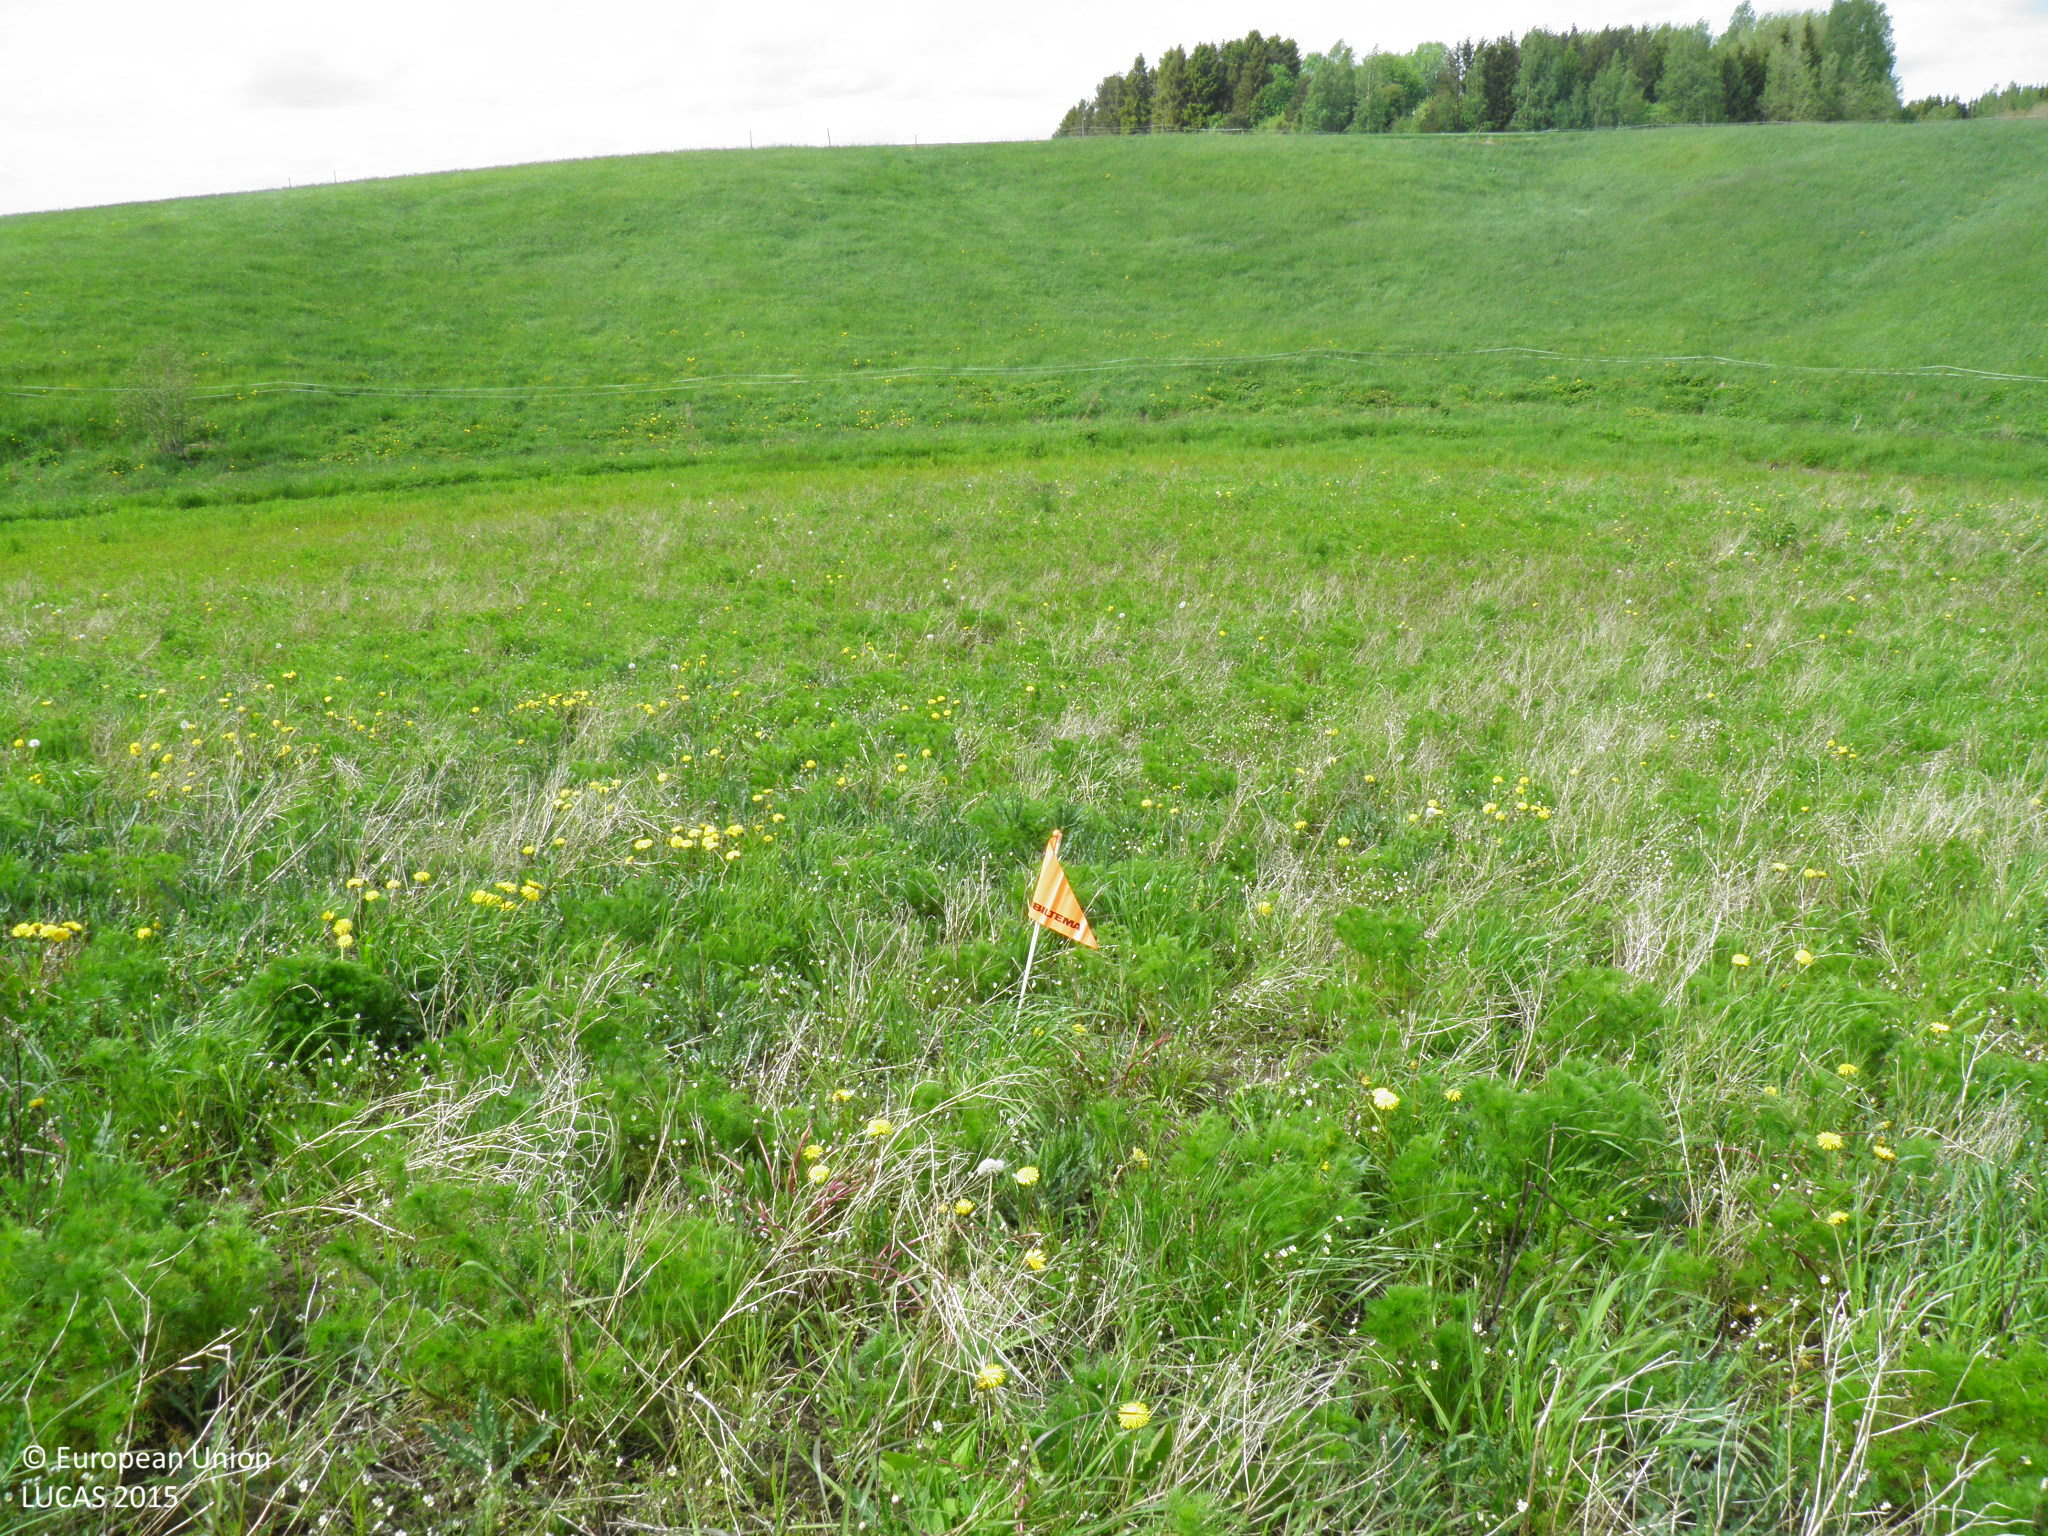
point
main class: Grassland
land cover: Grassland without tree/shrub cover
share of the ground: > 75 %
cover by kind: herbaceous plants 100 %
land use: Abandoned areas
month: June
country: FI
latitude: 60.4614
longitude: 22.7115
